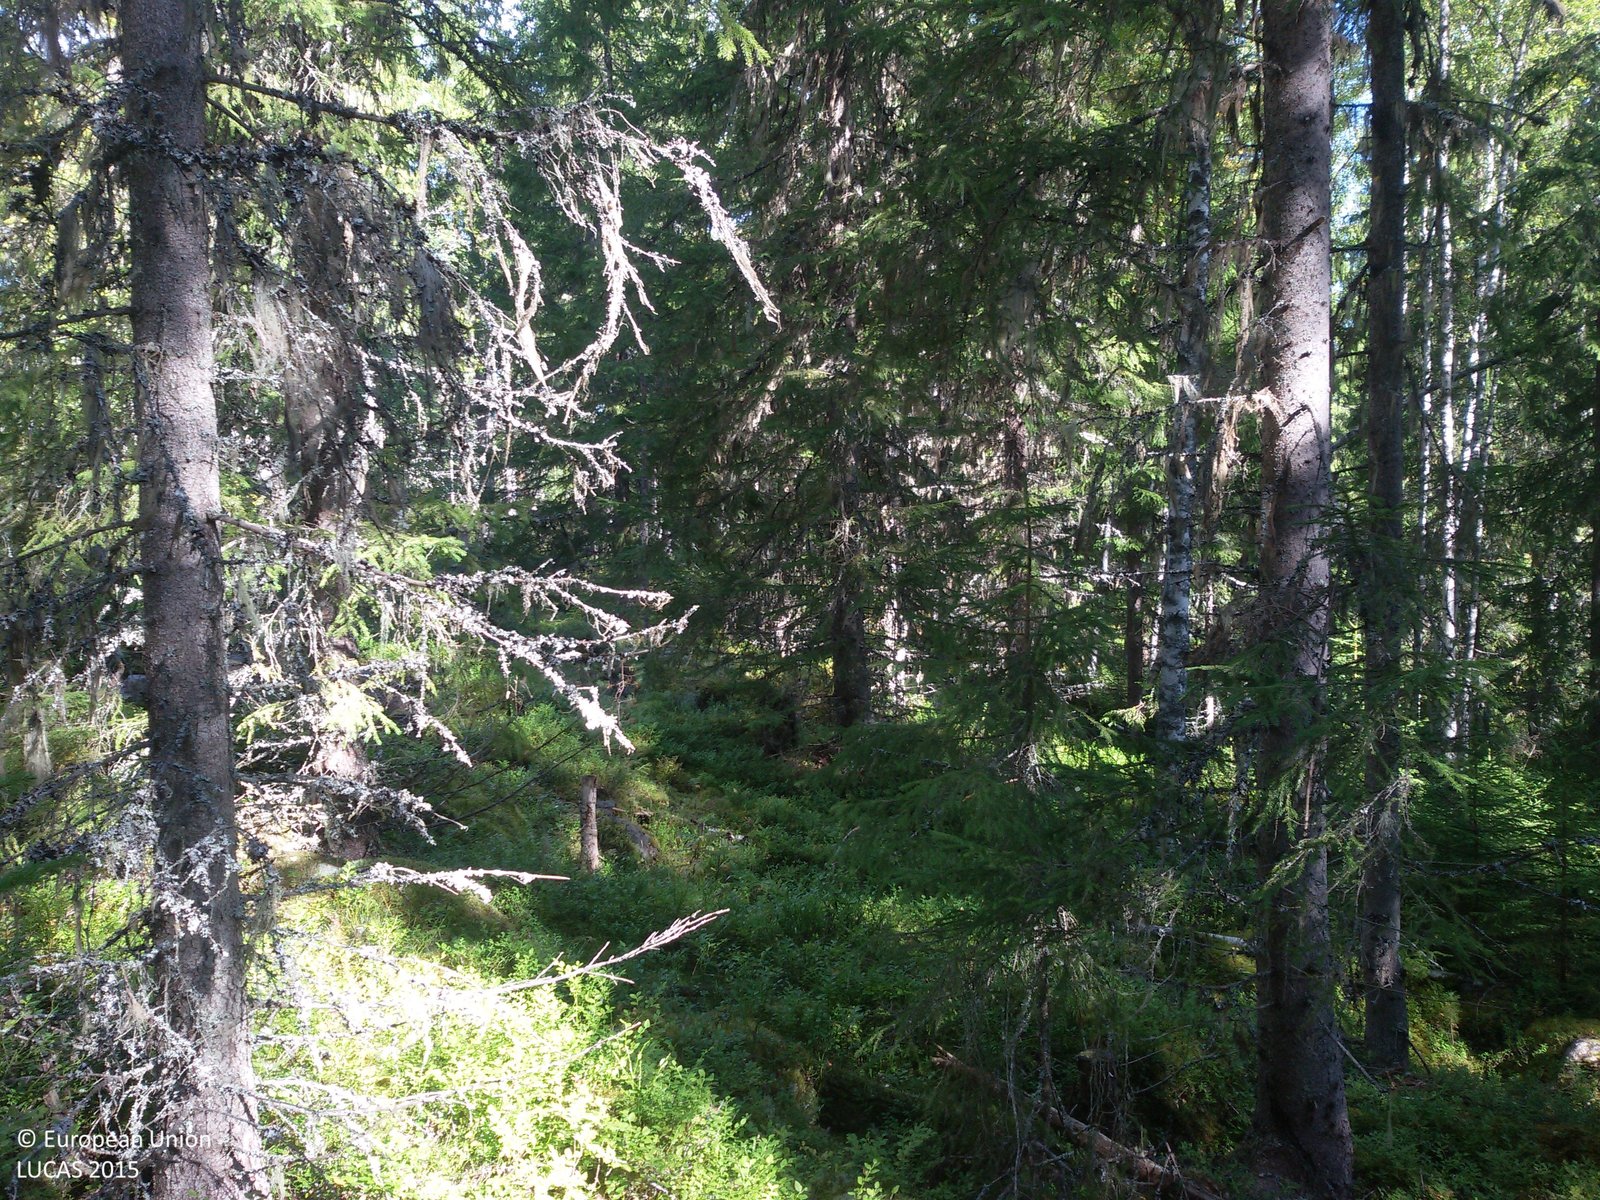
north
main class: Woodland
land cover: Spruce dominated mixed woodland
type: boreal forest
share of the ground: 50 - 75 %
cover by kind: coniferous forest trees 40 %, broadleaved forest trees 30 %, herbaceous plants 30 %
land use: Forestry
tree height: > 5 m
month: September
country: SE
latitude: 60.8763
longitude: 15.2727
